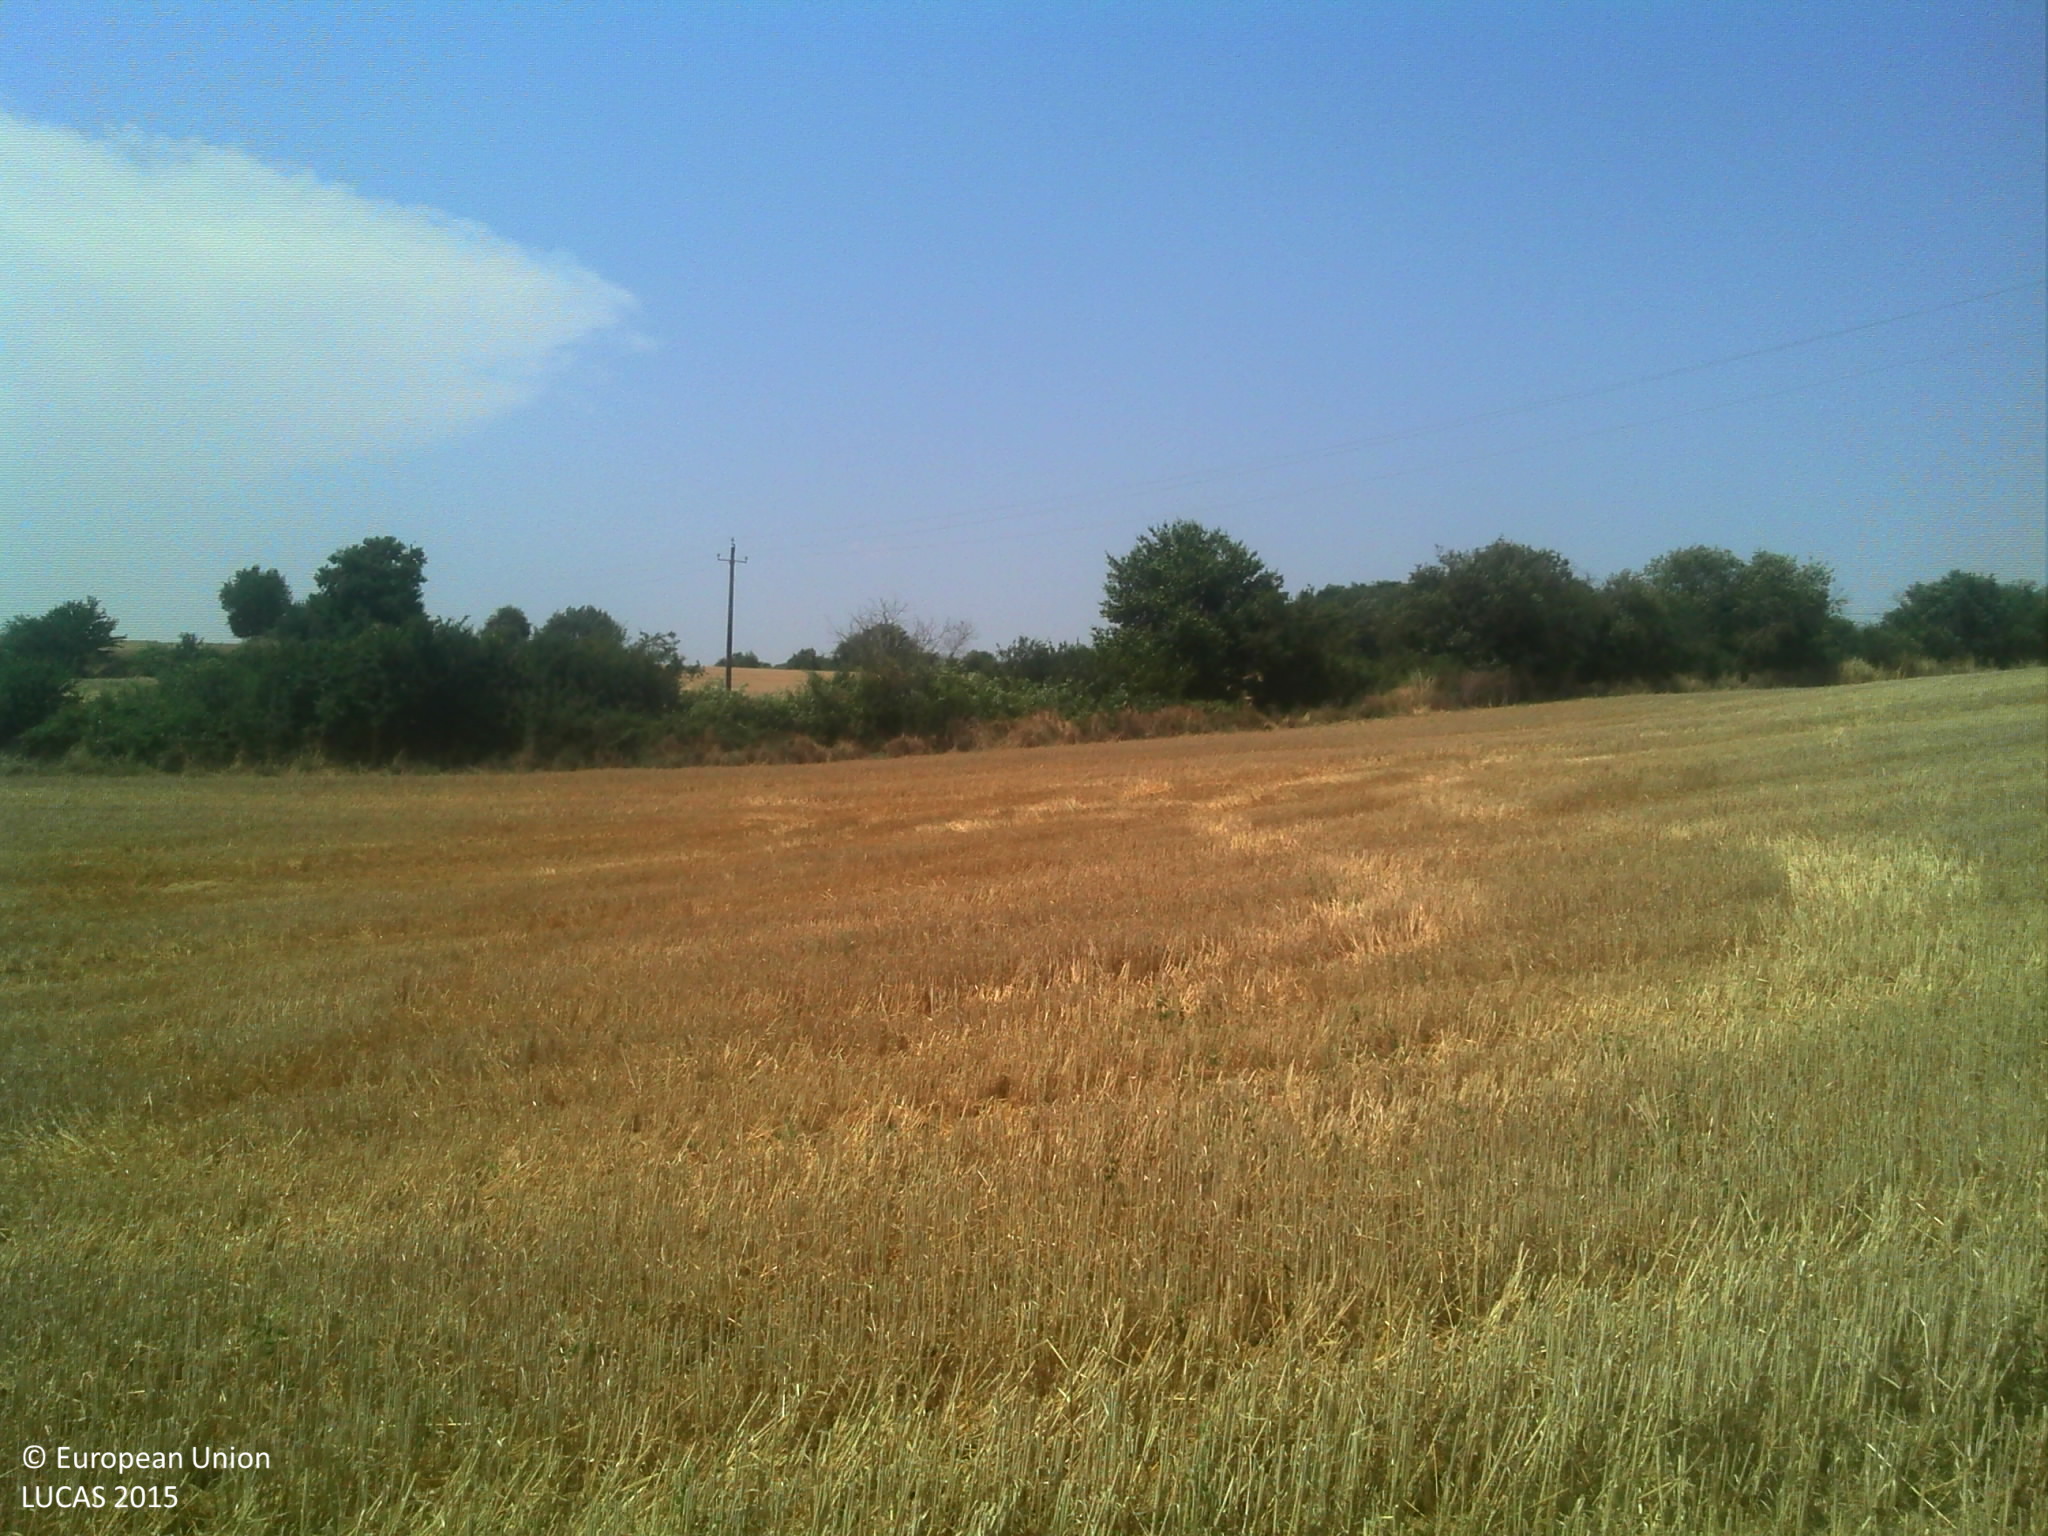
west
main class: Cropland
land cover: Common wheat
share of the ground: > 75 %
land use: Agriculture (excluding fallow land and kitchen gardens)
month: July
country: FR
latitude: 43.3671
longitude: 1.0800
